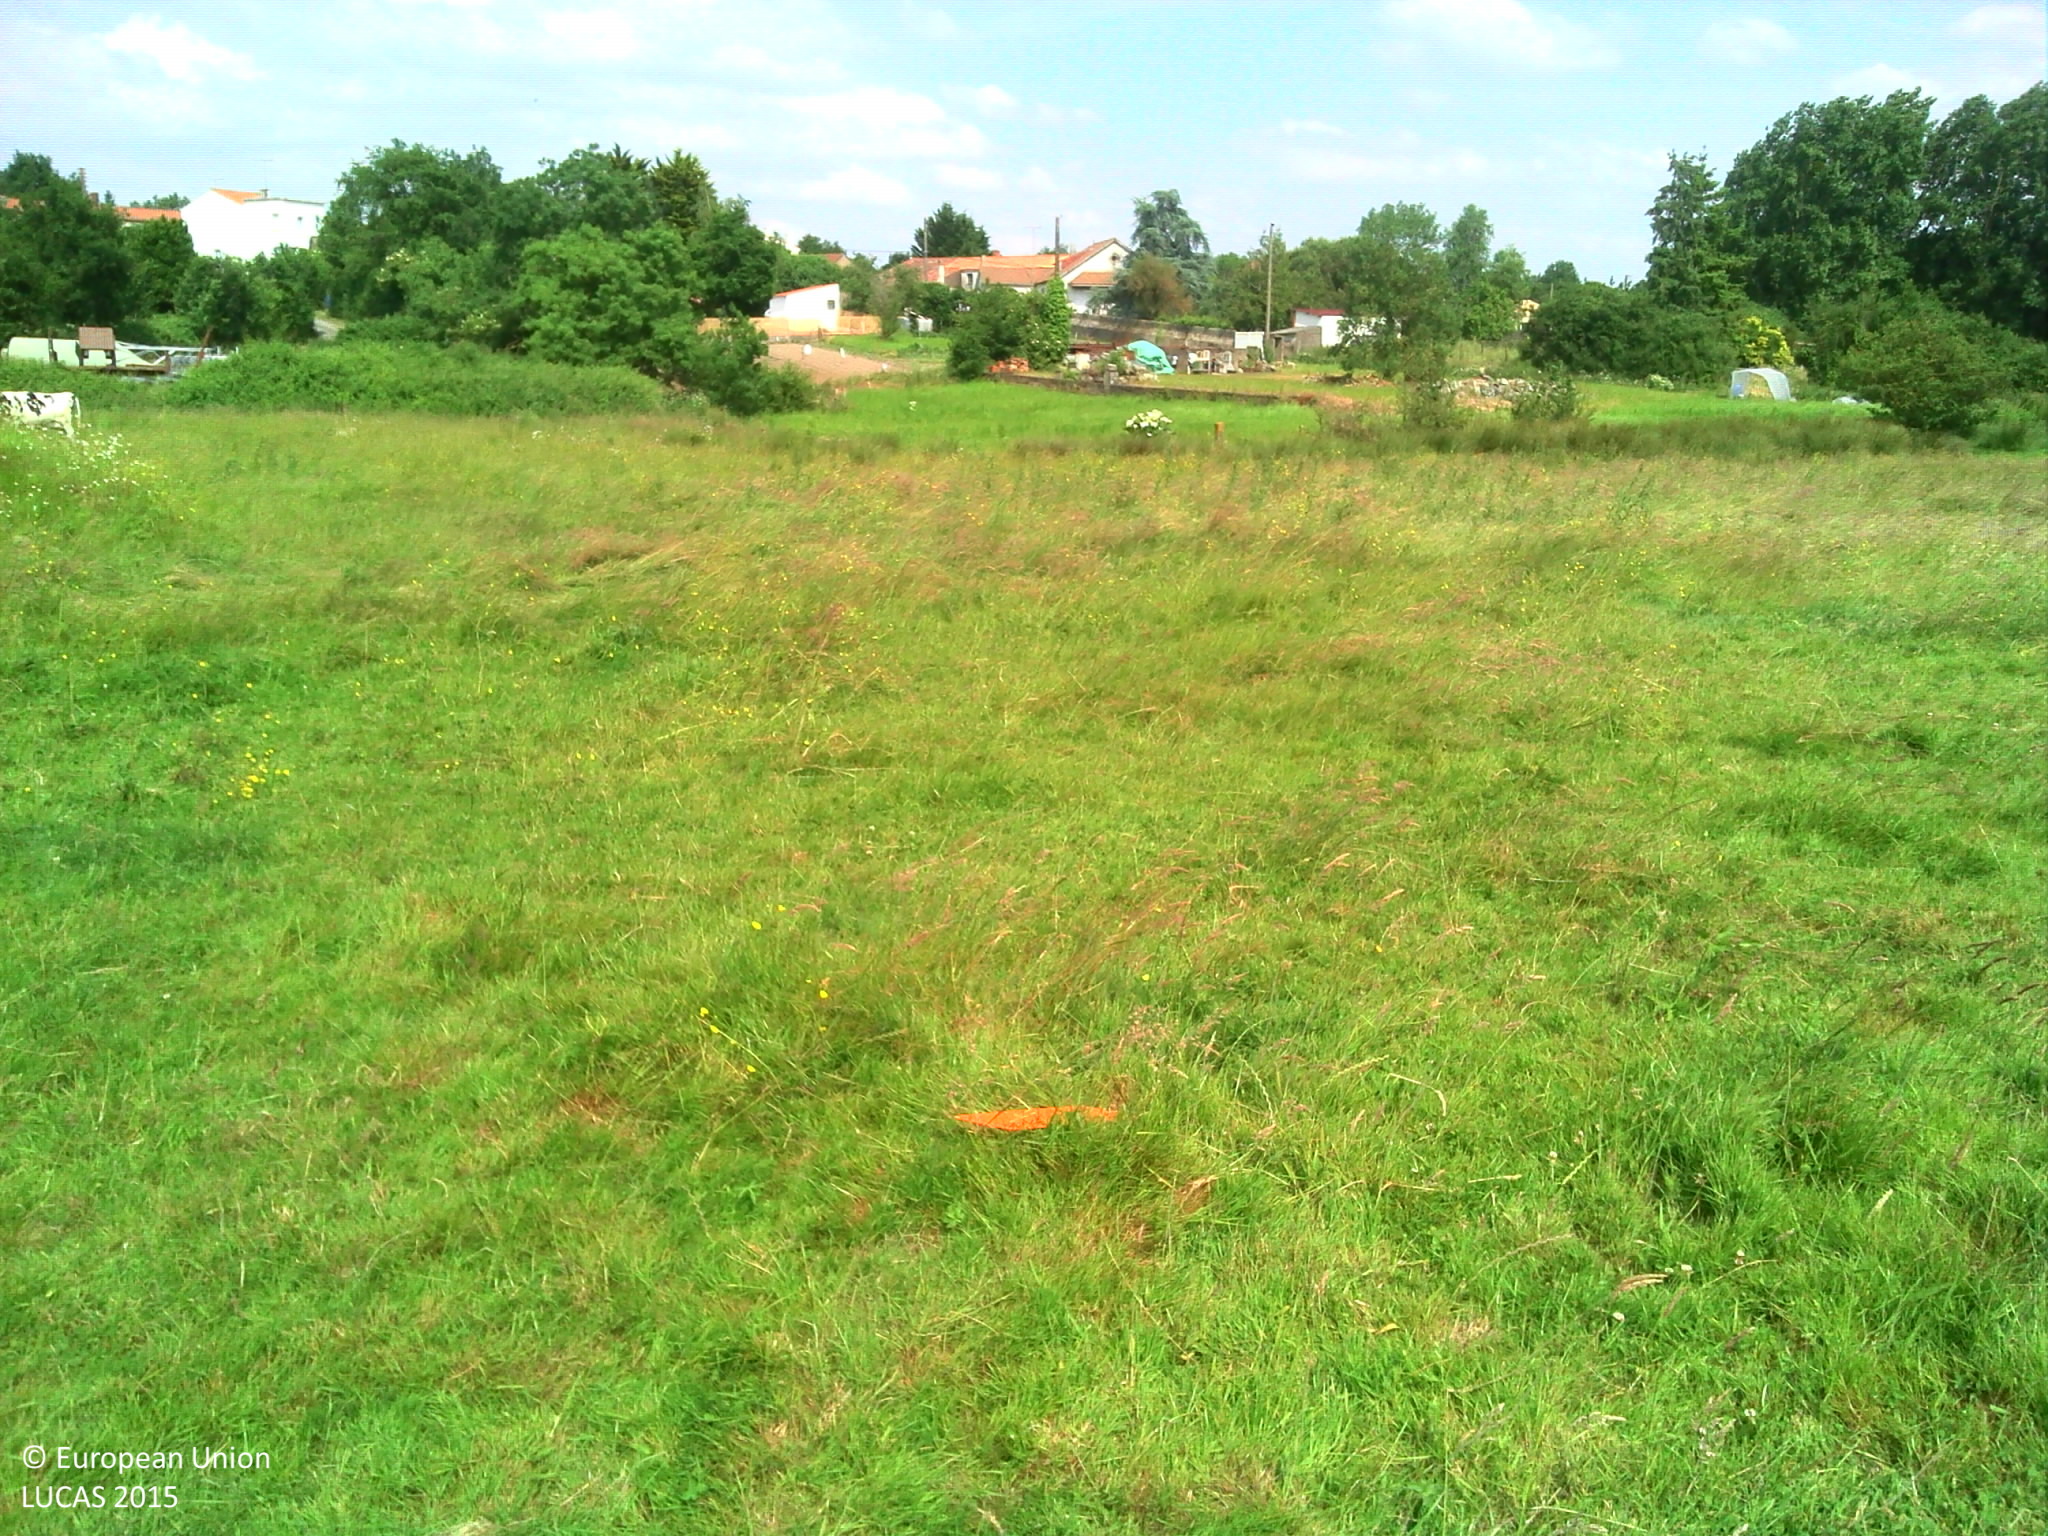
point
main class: Grassland
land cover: Grassland without tree/shrub cover
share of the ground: > 75 %
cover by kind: herbaceous plants 100 %
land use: Agriculture (excluding fallow land and kitchen gardens)
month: June
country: FR
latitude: 46.7871
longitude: -1.6339
